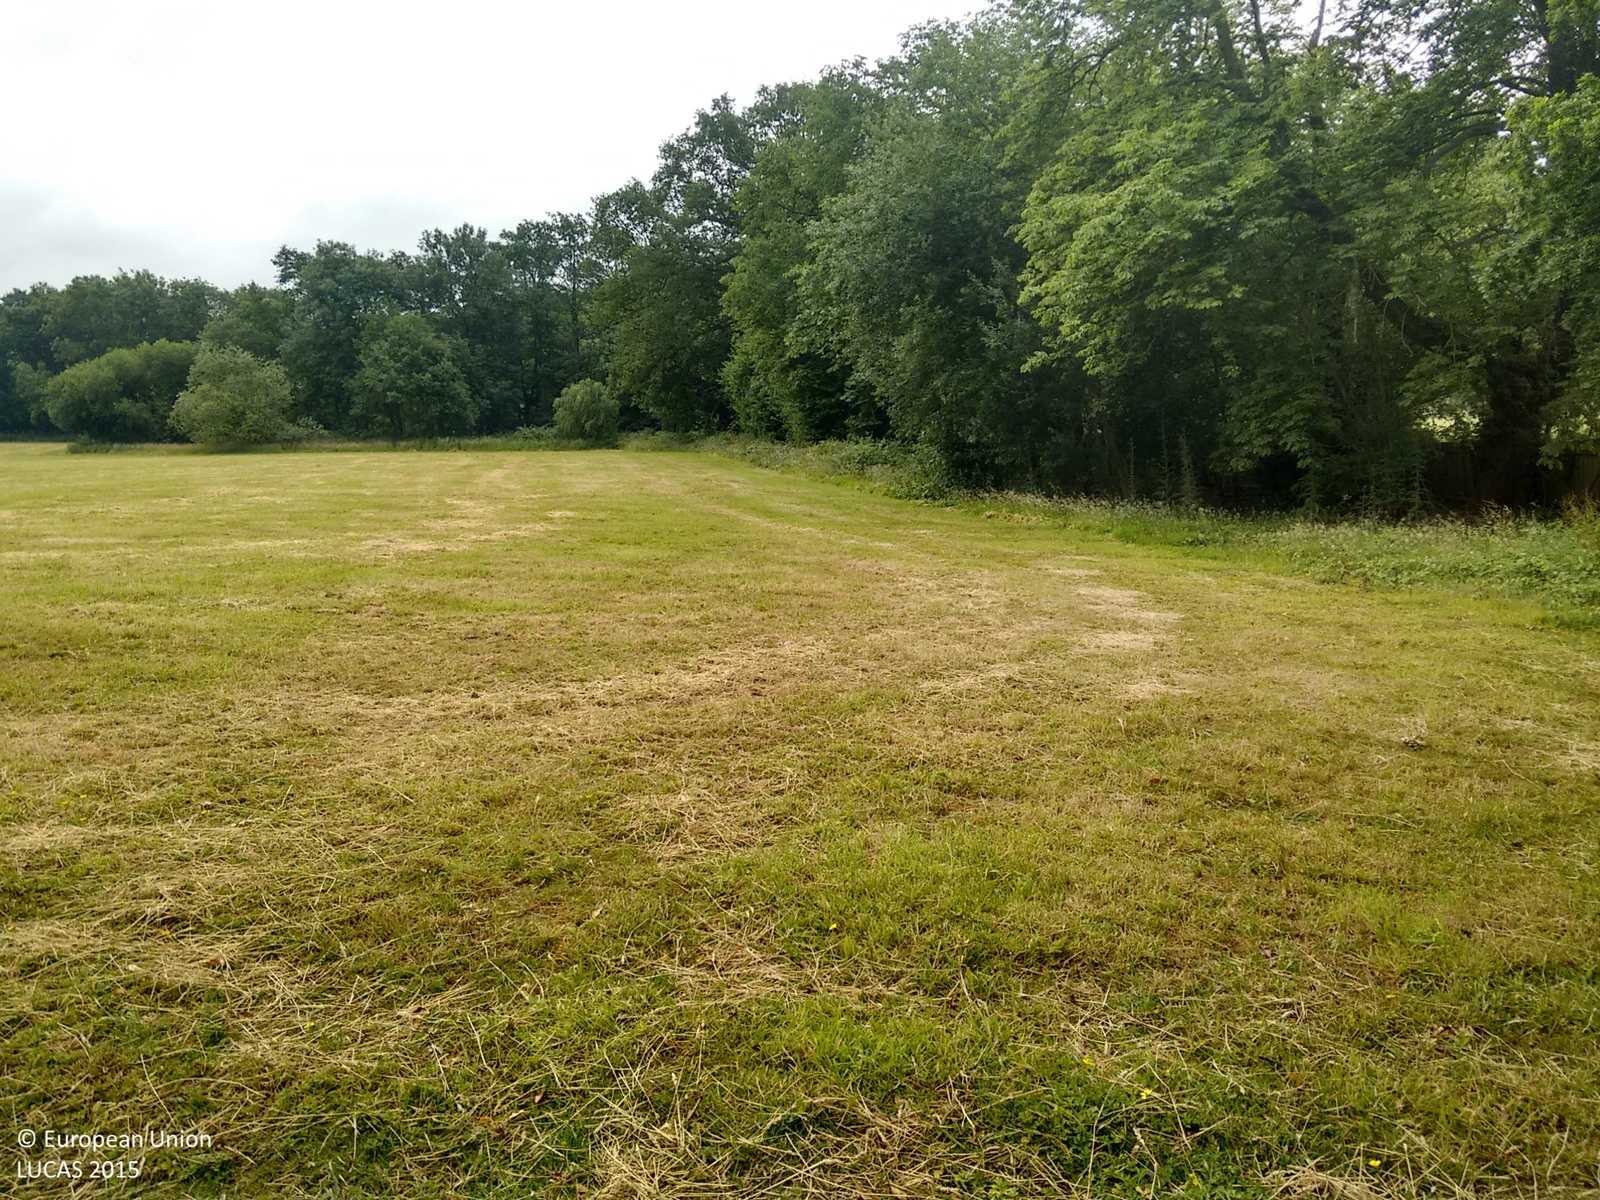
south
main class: Grassland
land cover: Grassland without tree/shrub cover
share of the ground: > 75 %
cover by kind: herbaceous plants 100 %
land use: Agriculture (excluding fallow land and kitchen gardens)
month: July
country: GB
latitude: 51.0331
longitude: -0.1734
